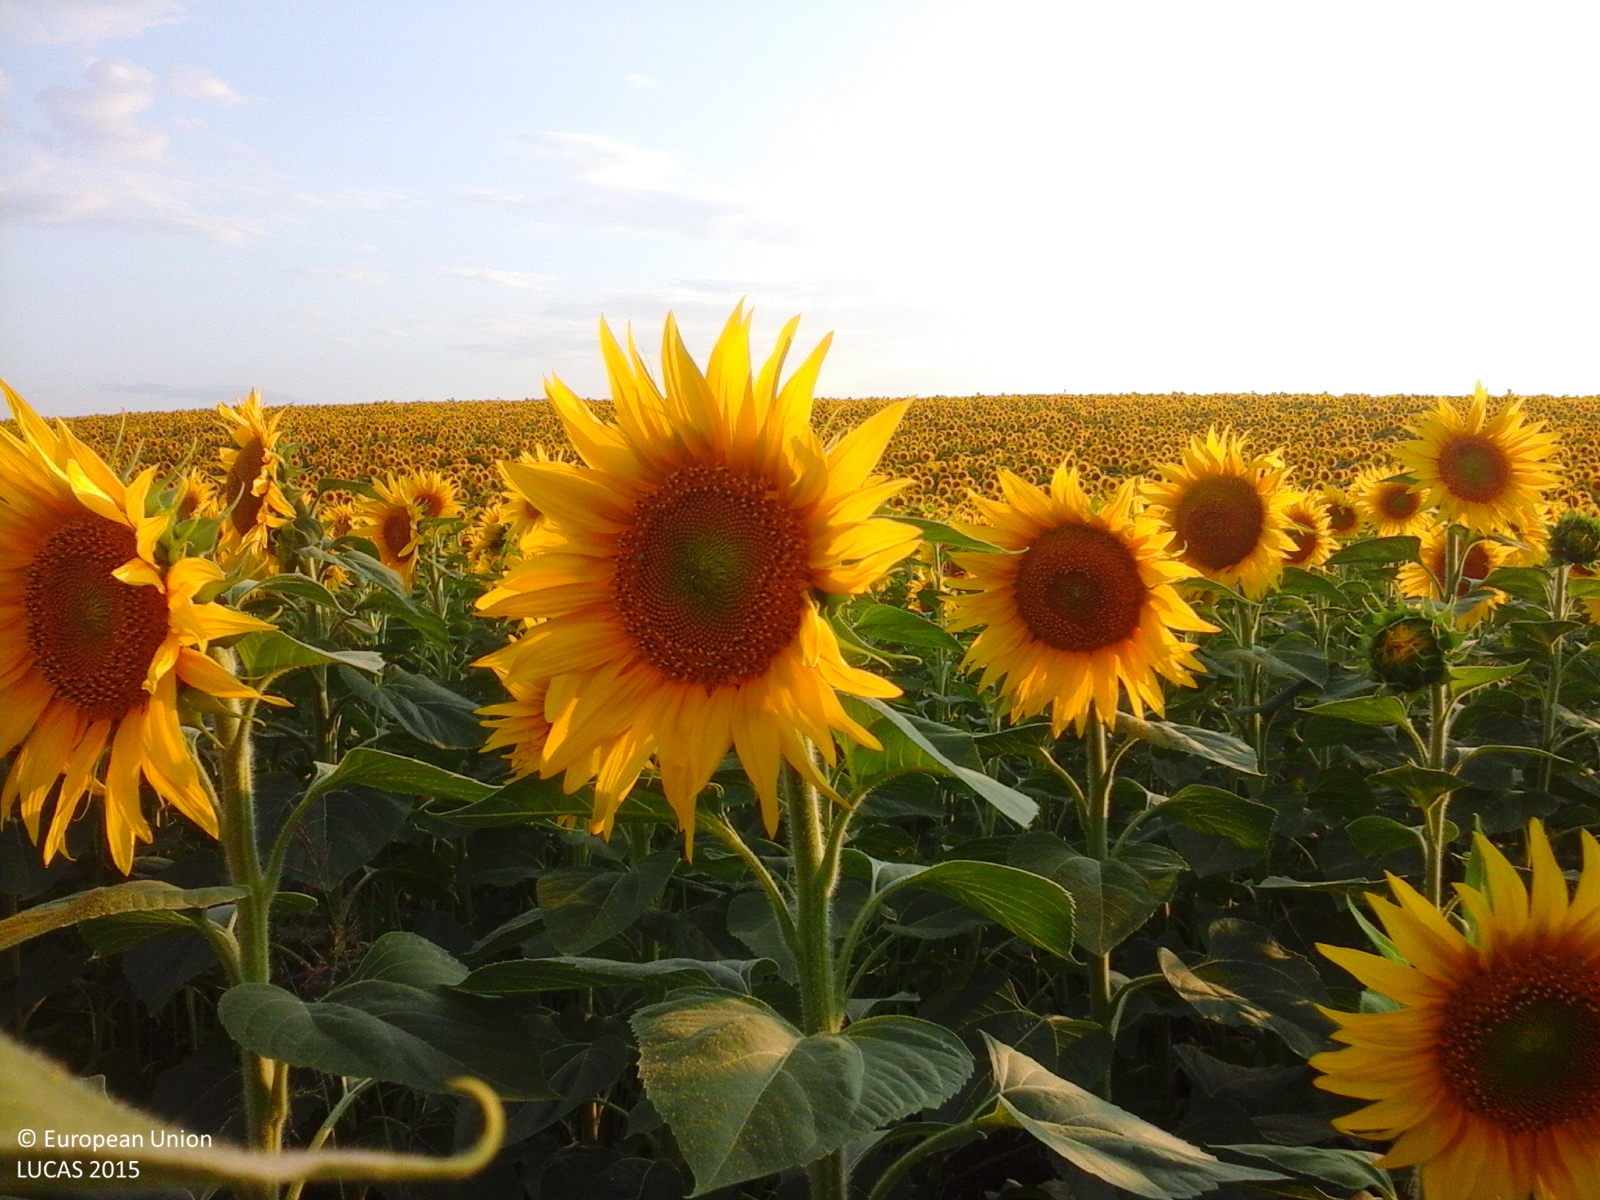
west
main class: Cropland
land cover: Sunflower
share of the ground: > 75 %
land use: Agriculture (excluding fallow land and kitchen gardens)
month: July
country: RO
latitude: 44.1123
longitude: 25.9793
